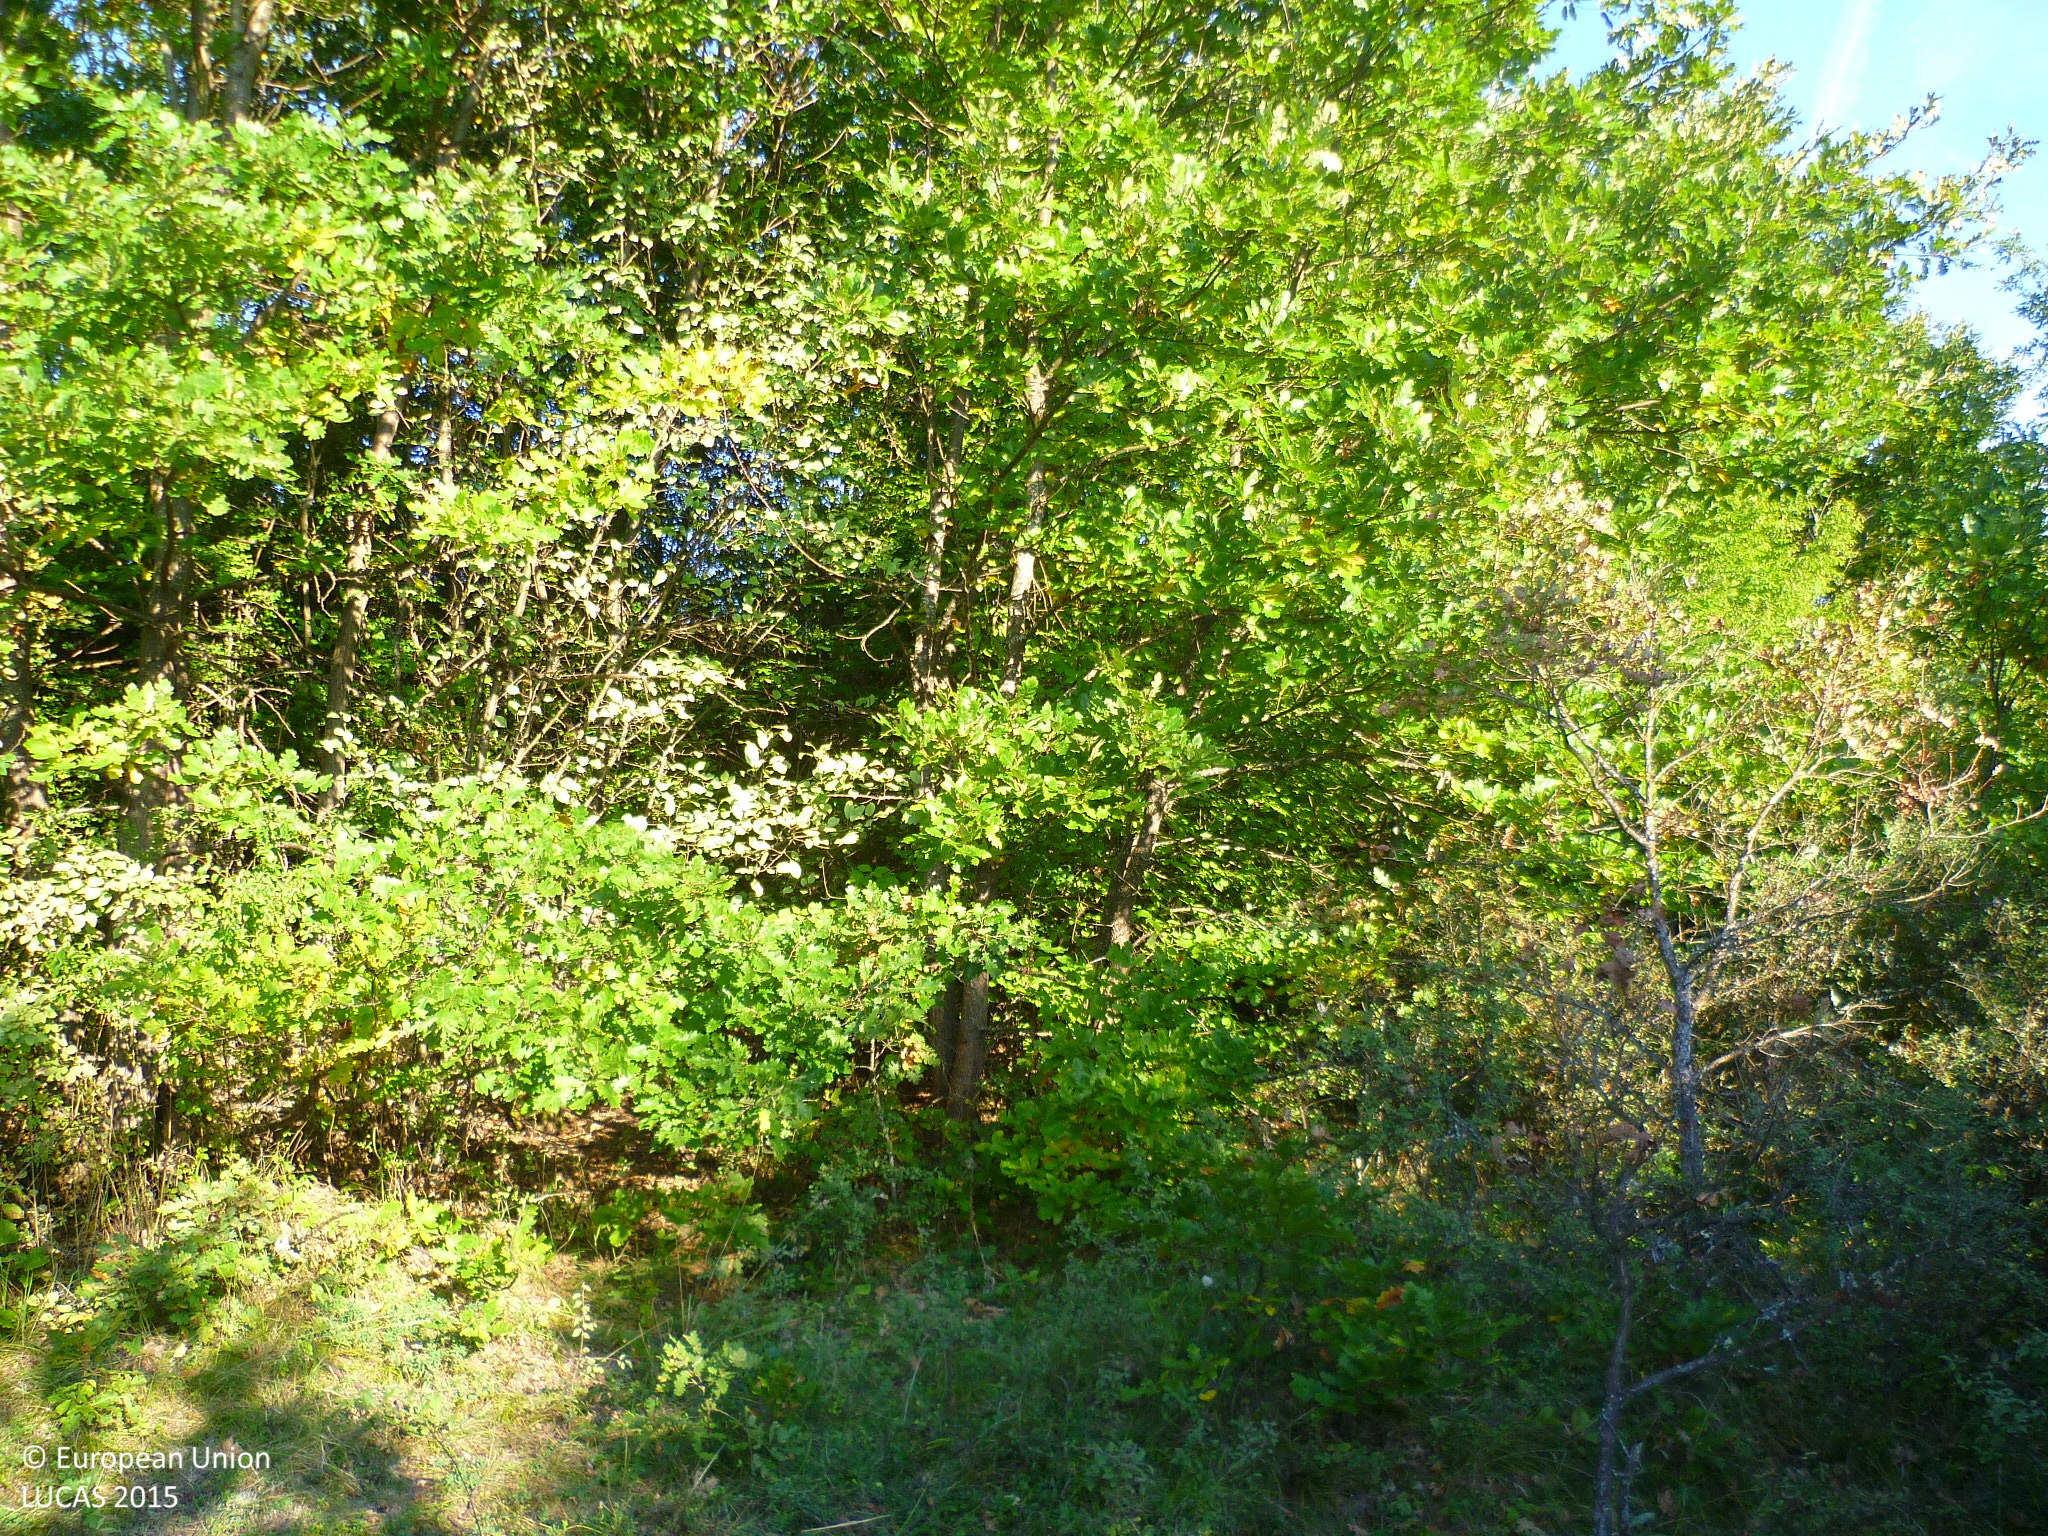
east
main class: Woodland
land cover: Broadleaved woodland
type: mesophytic deciduous forest
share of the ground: 50 - 75 %
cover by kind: broadleaved forest trees 60 %, herbaceous plants 15 %, coniferous forest trees 10 %, shrubs 10 %, unconsolidated bare surface 5 %
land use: Semi-natural and natural areas not in use
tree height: > 5 m
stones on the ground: 25 - 50 %
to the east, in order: Broadleaved woodland; Shrubland with sparse tree cover; Broadleaved woodland; Shrubland with sparse tree cover; Broadleaved woodland
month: October
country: BG
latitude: 43.0414
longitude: 22.9580
